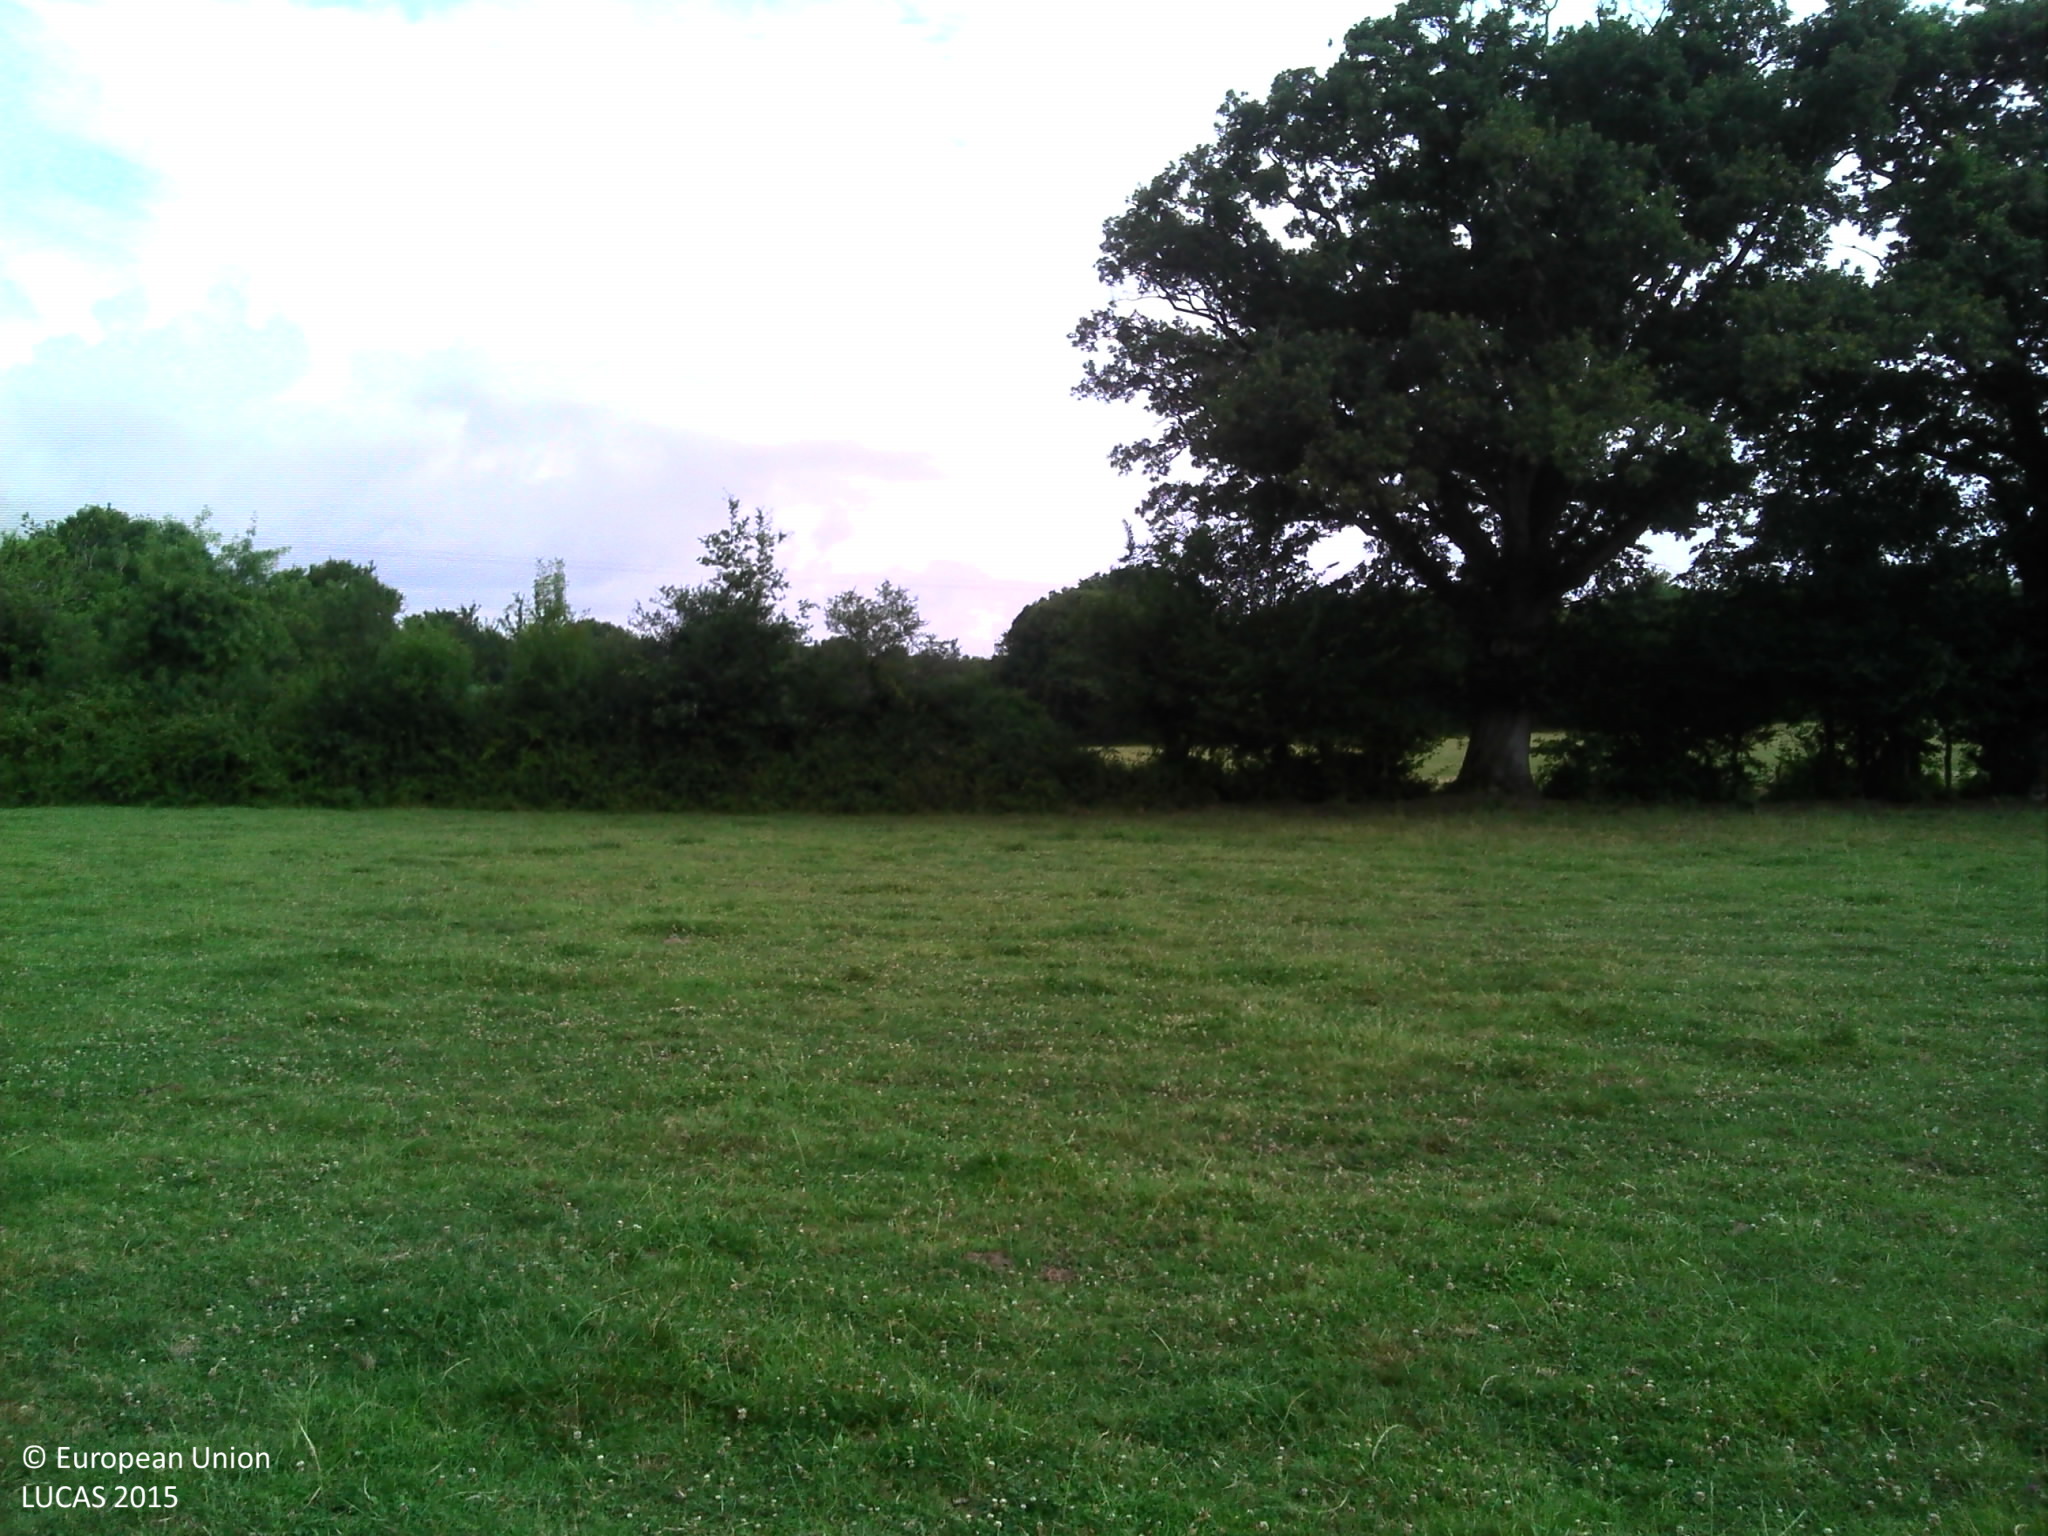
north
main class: Grassland
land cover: Grassland without tree/shrub cover
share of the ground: > 75 %
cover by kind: herbaceous plants 100 %
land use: Agriculture (excluding fallow land and kitchen gardens)
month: July
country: FR
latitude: 47.0746
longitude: -1.8317
